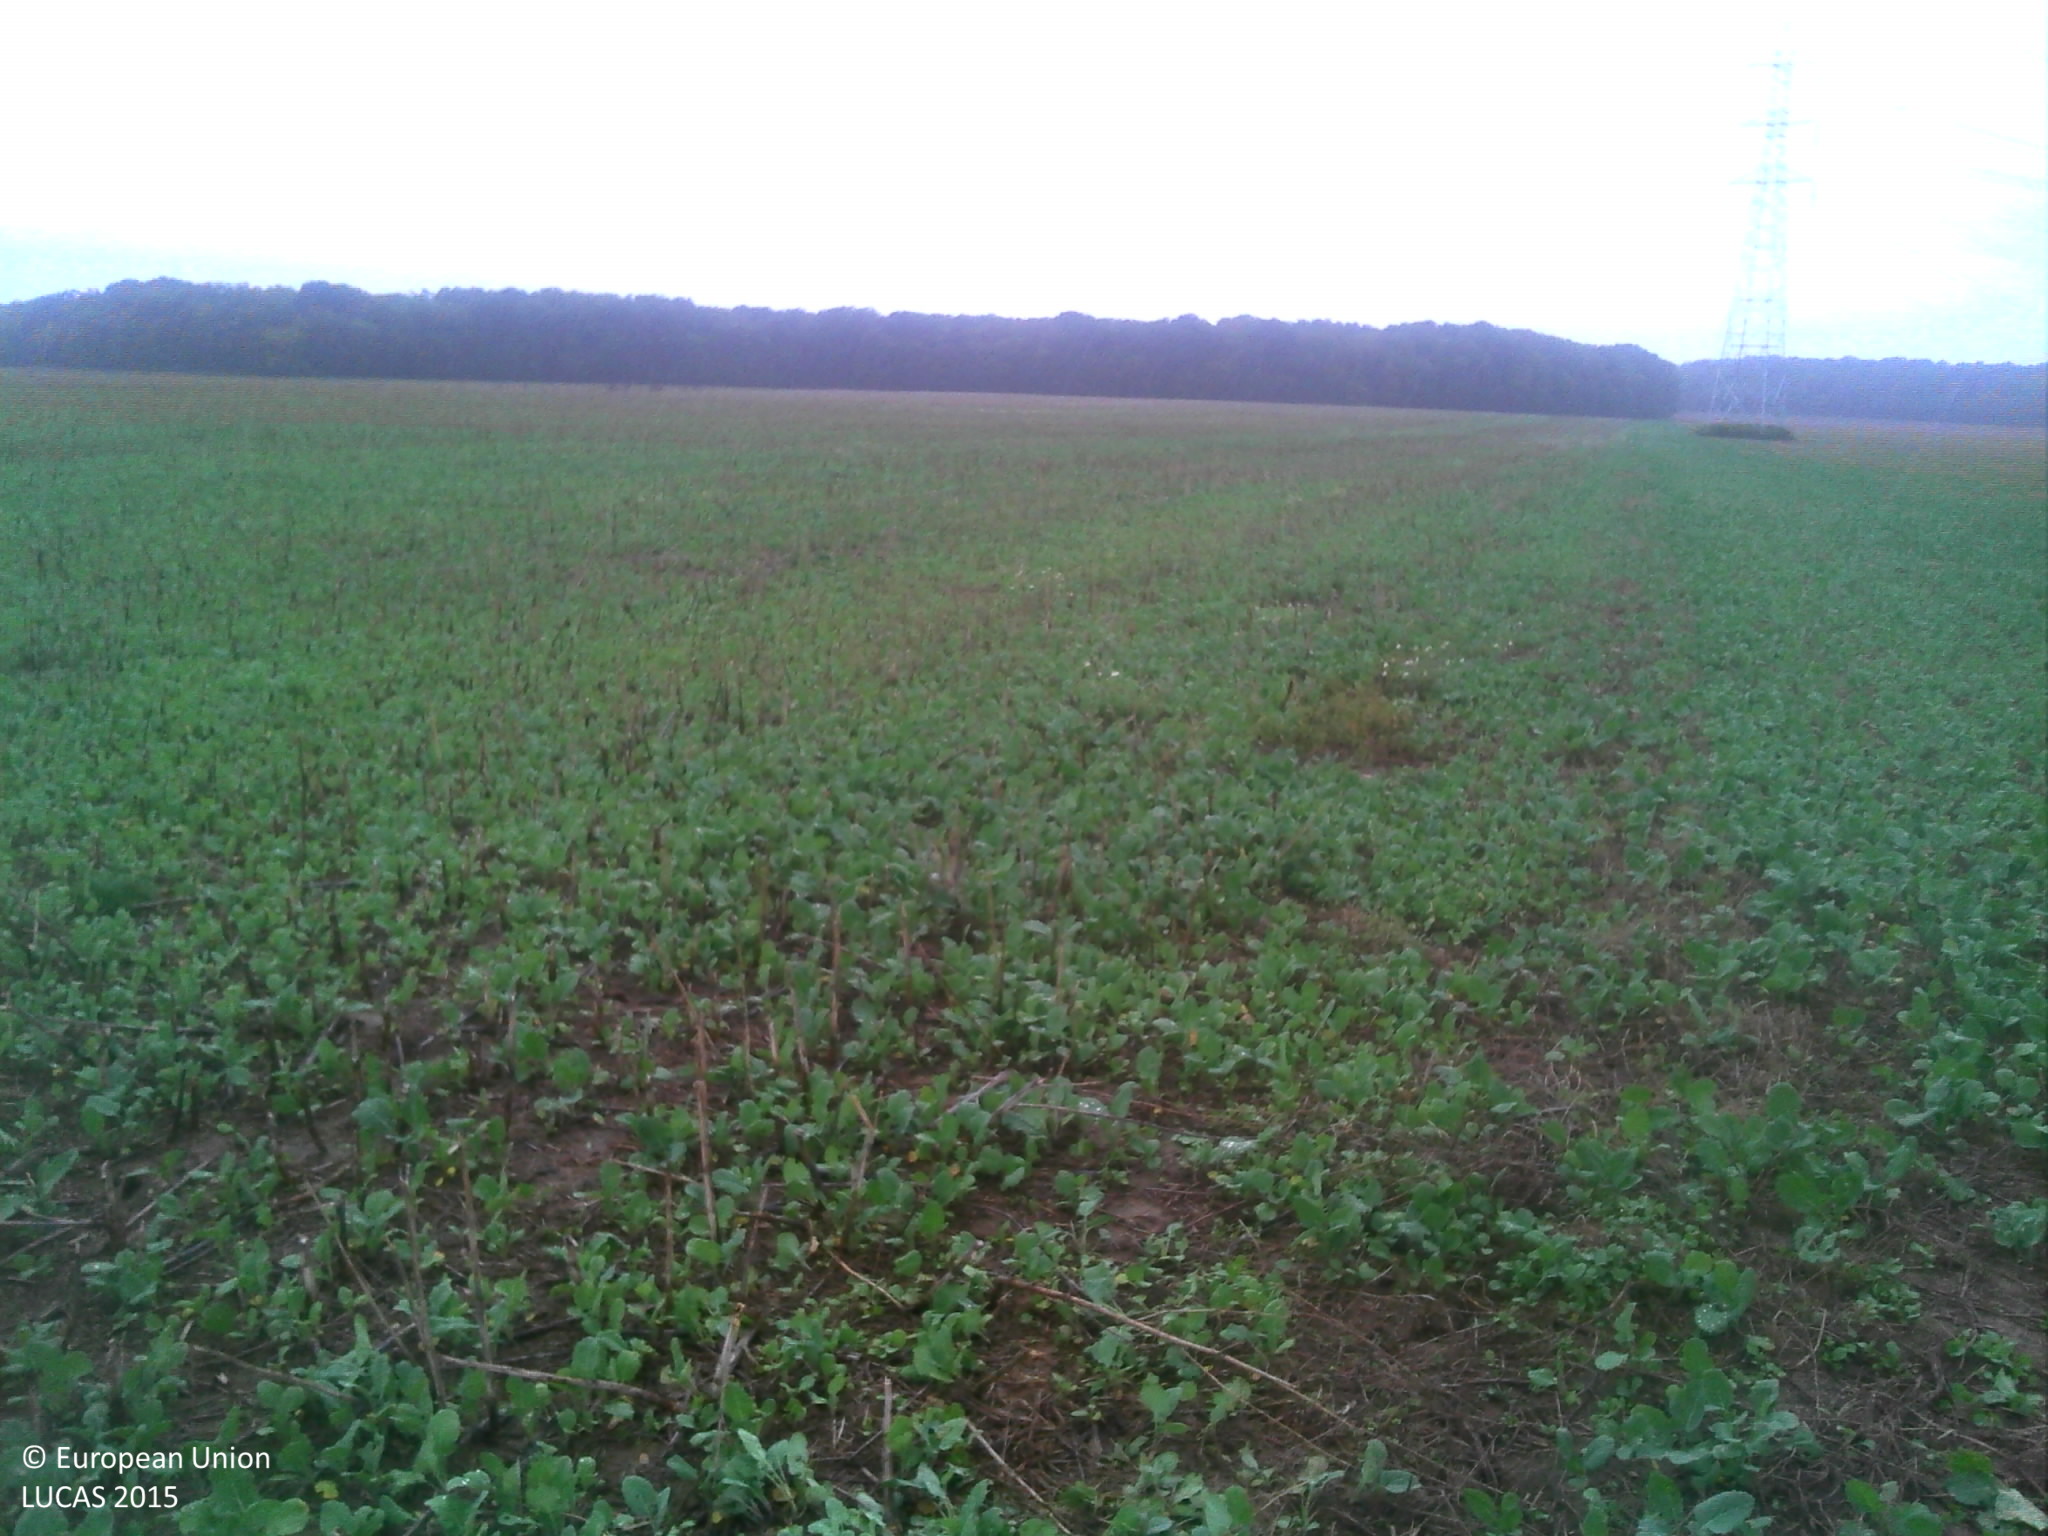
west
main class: Cropland
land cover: Rape and turnip rape
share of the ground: 10 - 25 %
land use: Agriculture (excluding fallow land and kitchen gardens)
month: September
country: FR
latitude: 49.2628
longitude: 5.8630
